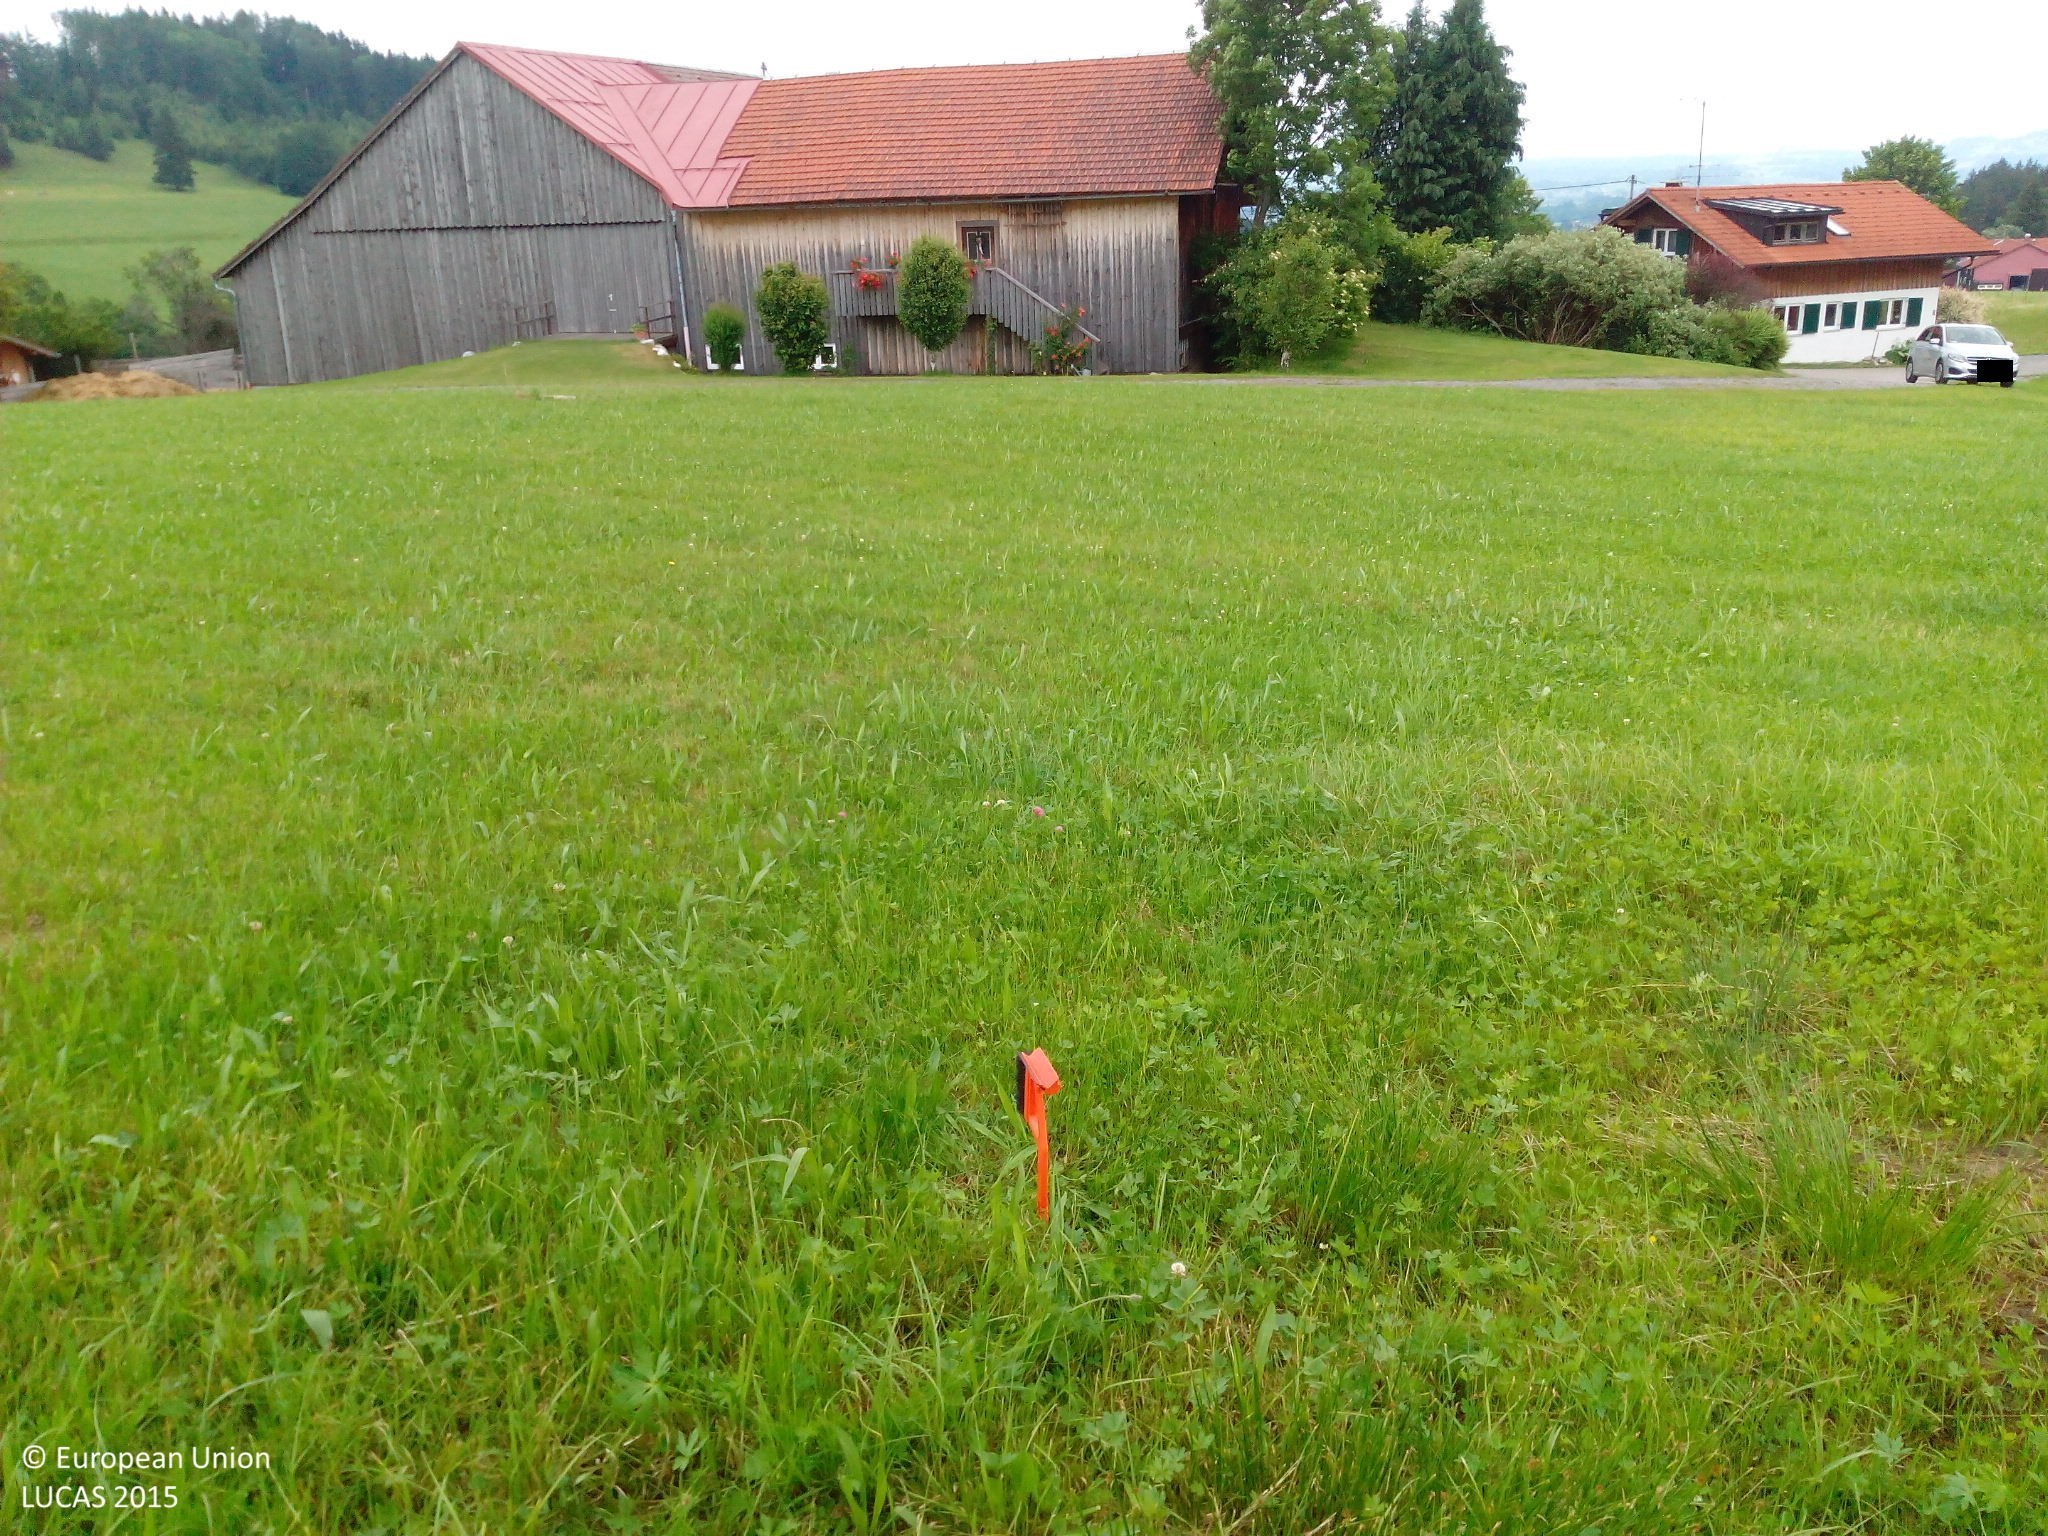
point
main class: Grassland
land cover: Grassland without tree/shrub cover
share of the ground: > 75 %
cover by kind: herbaceous plants 100 %
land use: Agriculture (excluding fallow land and kitchen gardens)
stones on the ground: < 10 %
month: June
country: DE
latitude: 47.6473
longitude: 10.2527
